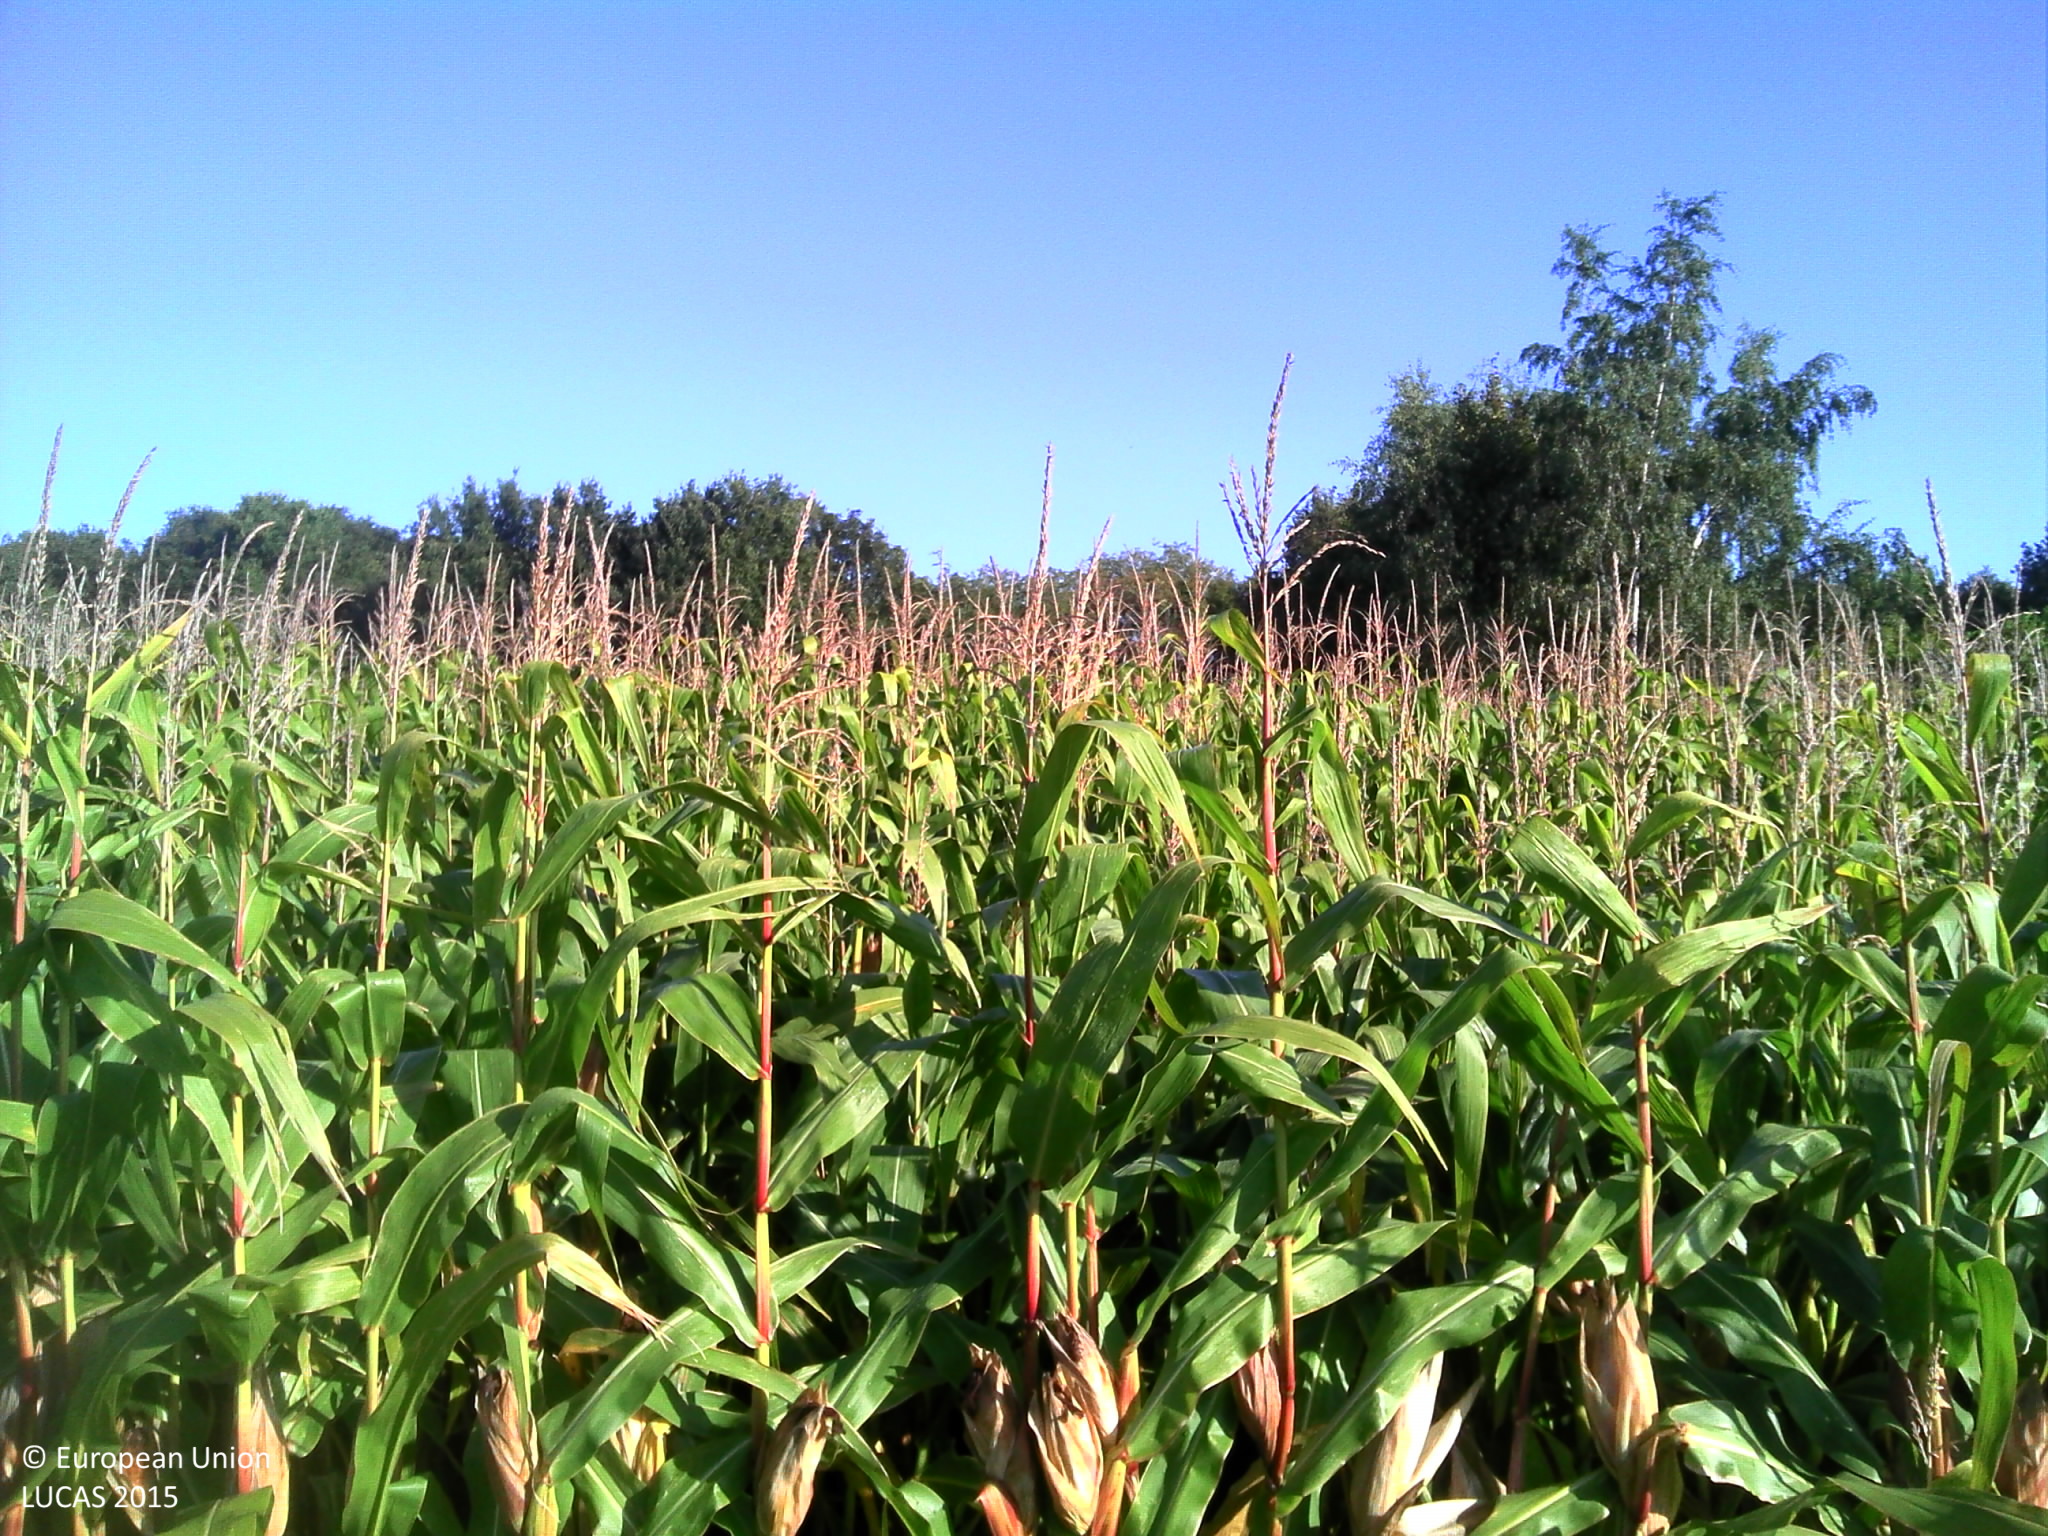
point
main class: Cropland
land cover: Maize
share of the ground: > 75 %
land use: Agriculture (excluding fallow land and kitchen gardens)
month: September
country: BE
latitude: 51.0940
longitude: 4.4412
